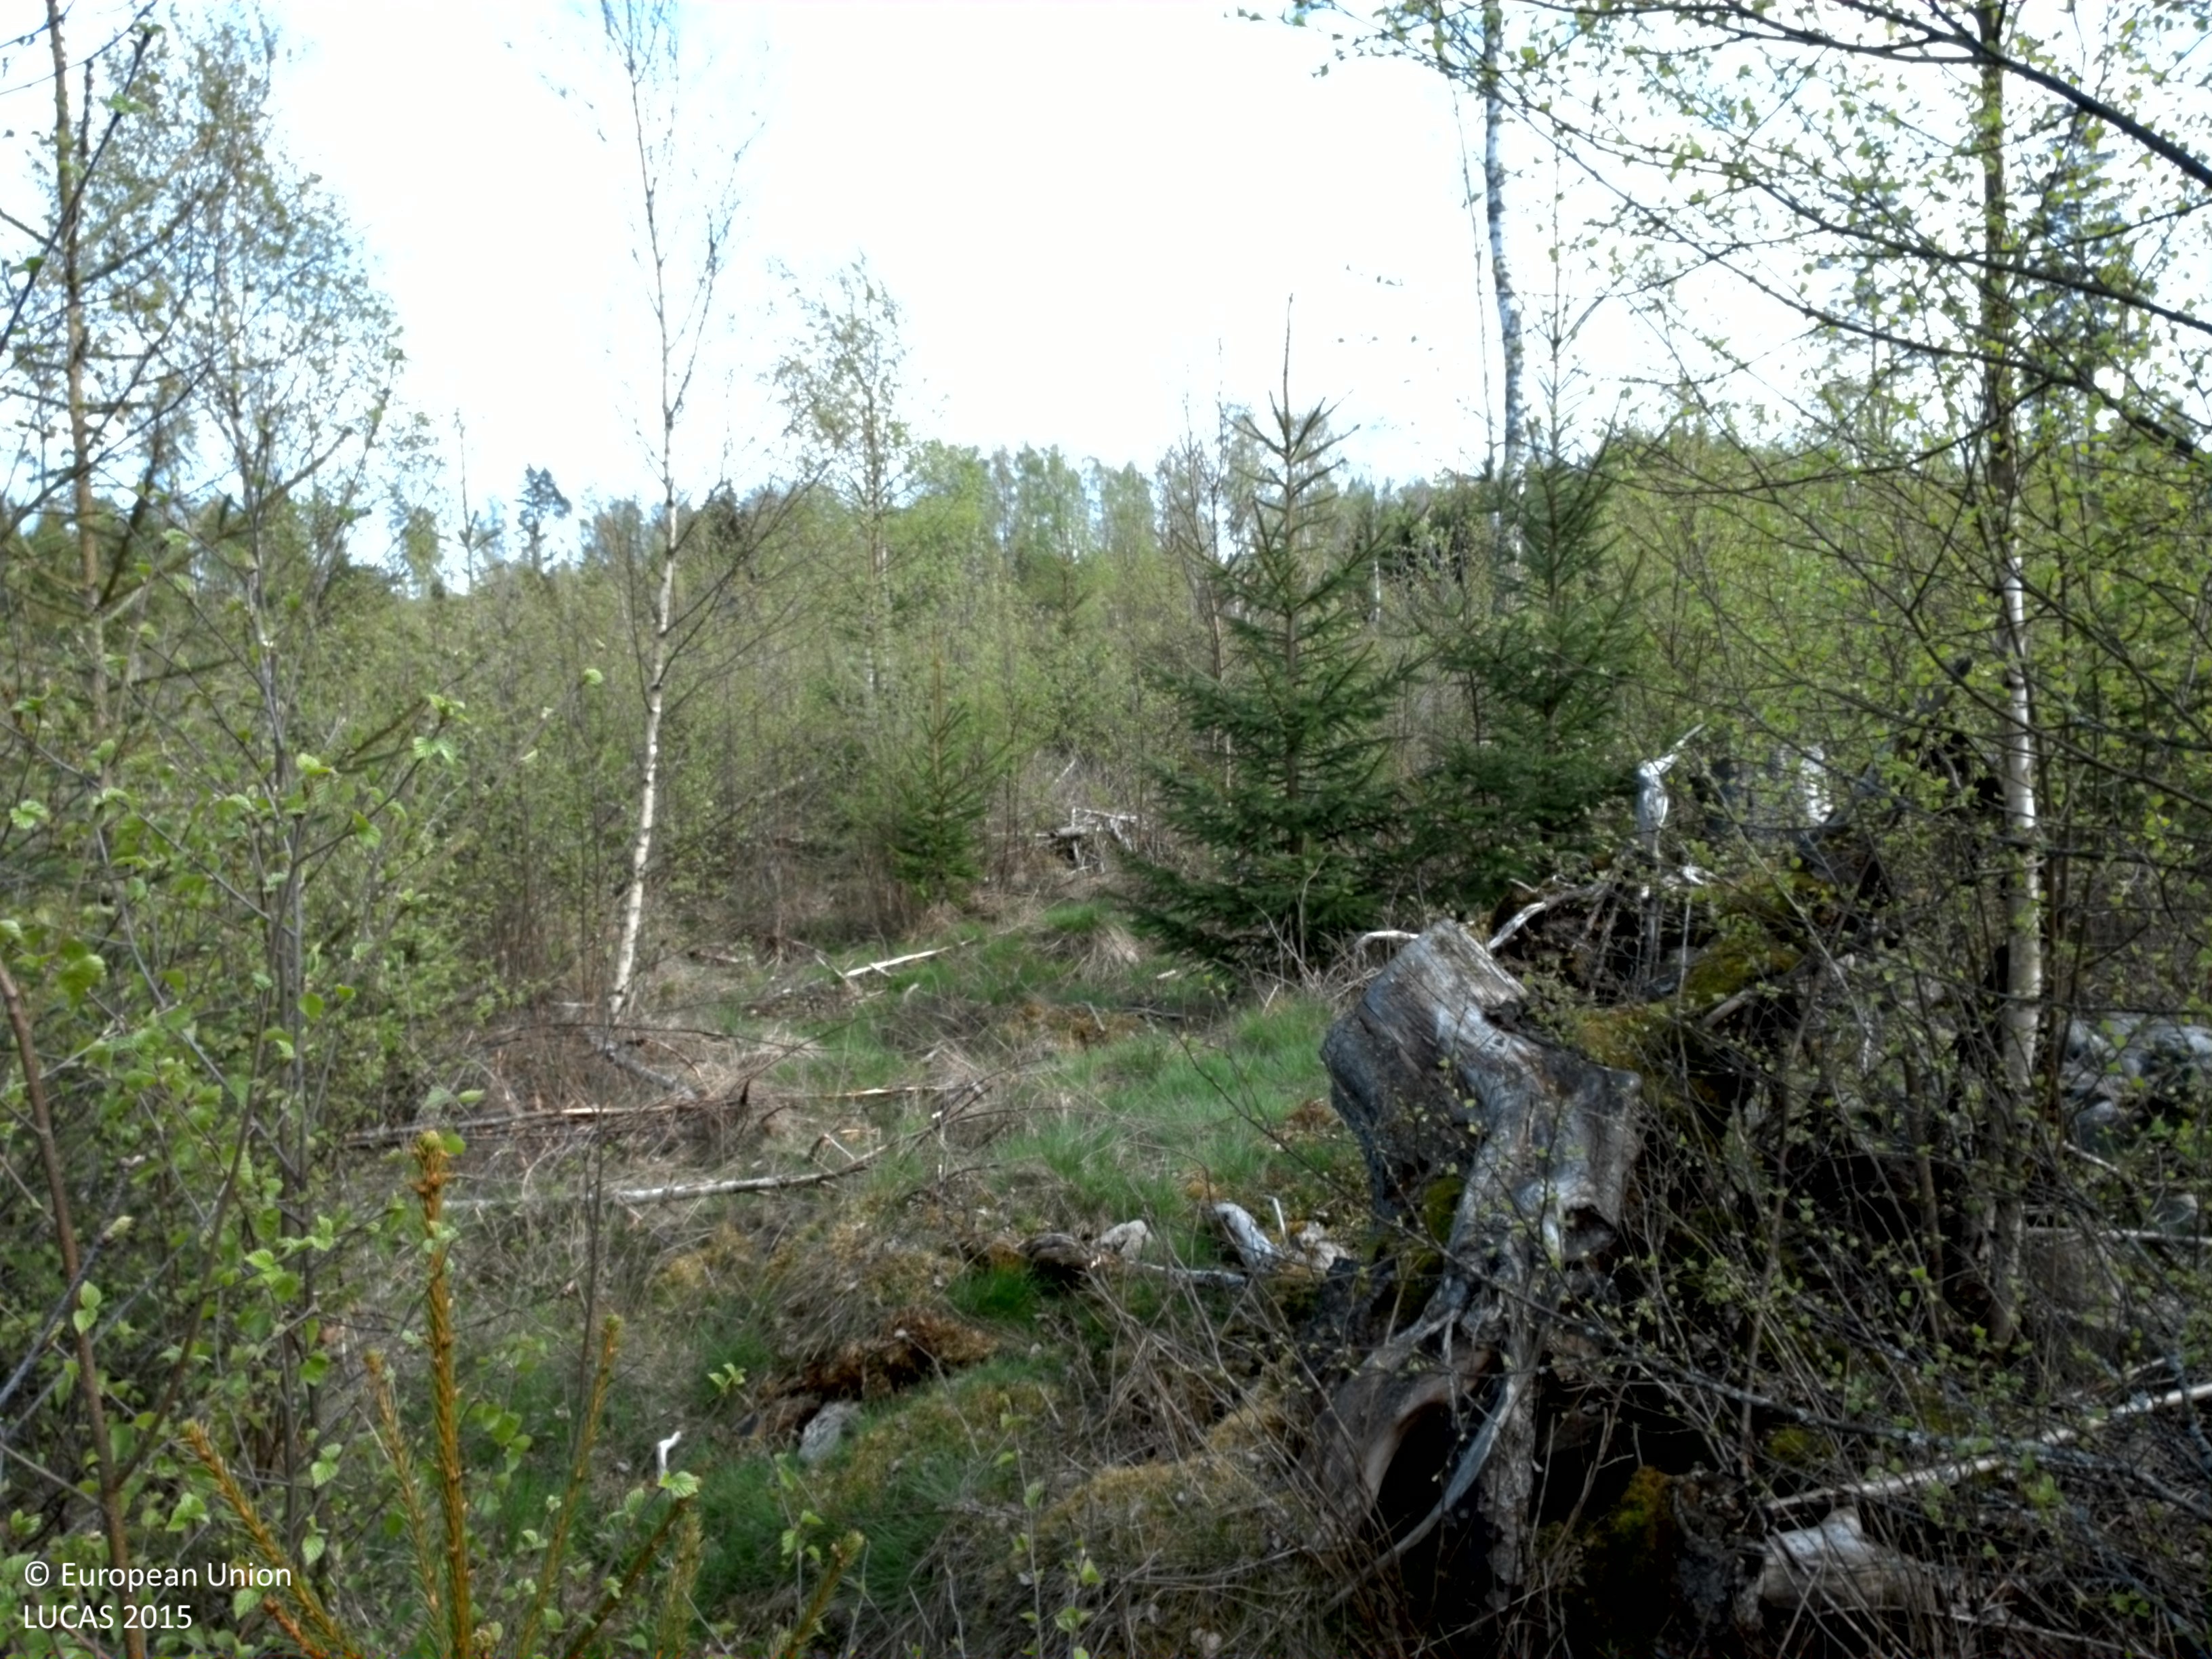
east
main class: Woodland
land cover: Spruce dominated mixed woodland
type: boreal forest
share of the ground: 50 - 75 %
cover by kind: broadleaved forest trees 40 %, coniferous forest trees 30 %, herbaceous plants 15 %, lichens and mosses 15 %
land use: Forestry
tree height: > 5 m
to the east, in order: Spruce dominated mixed woodland; Spruce dominated coniferous woodland; Broadleaved woodland; Electric lines; Shrubland with sparse tree cover; Spruce dominated mixed woodland
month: May
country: SE
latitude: 56.6931
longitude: 14.7817
